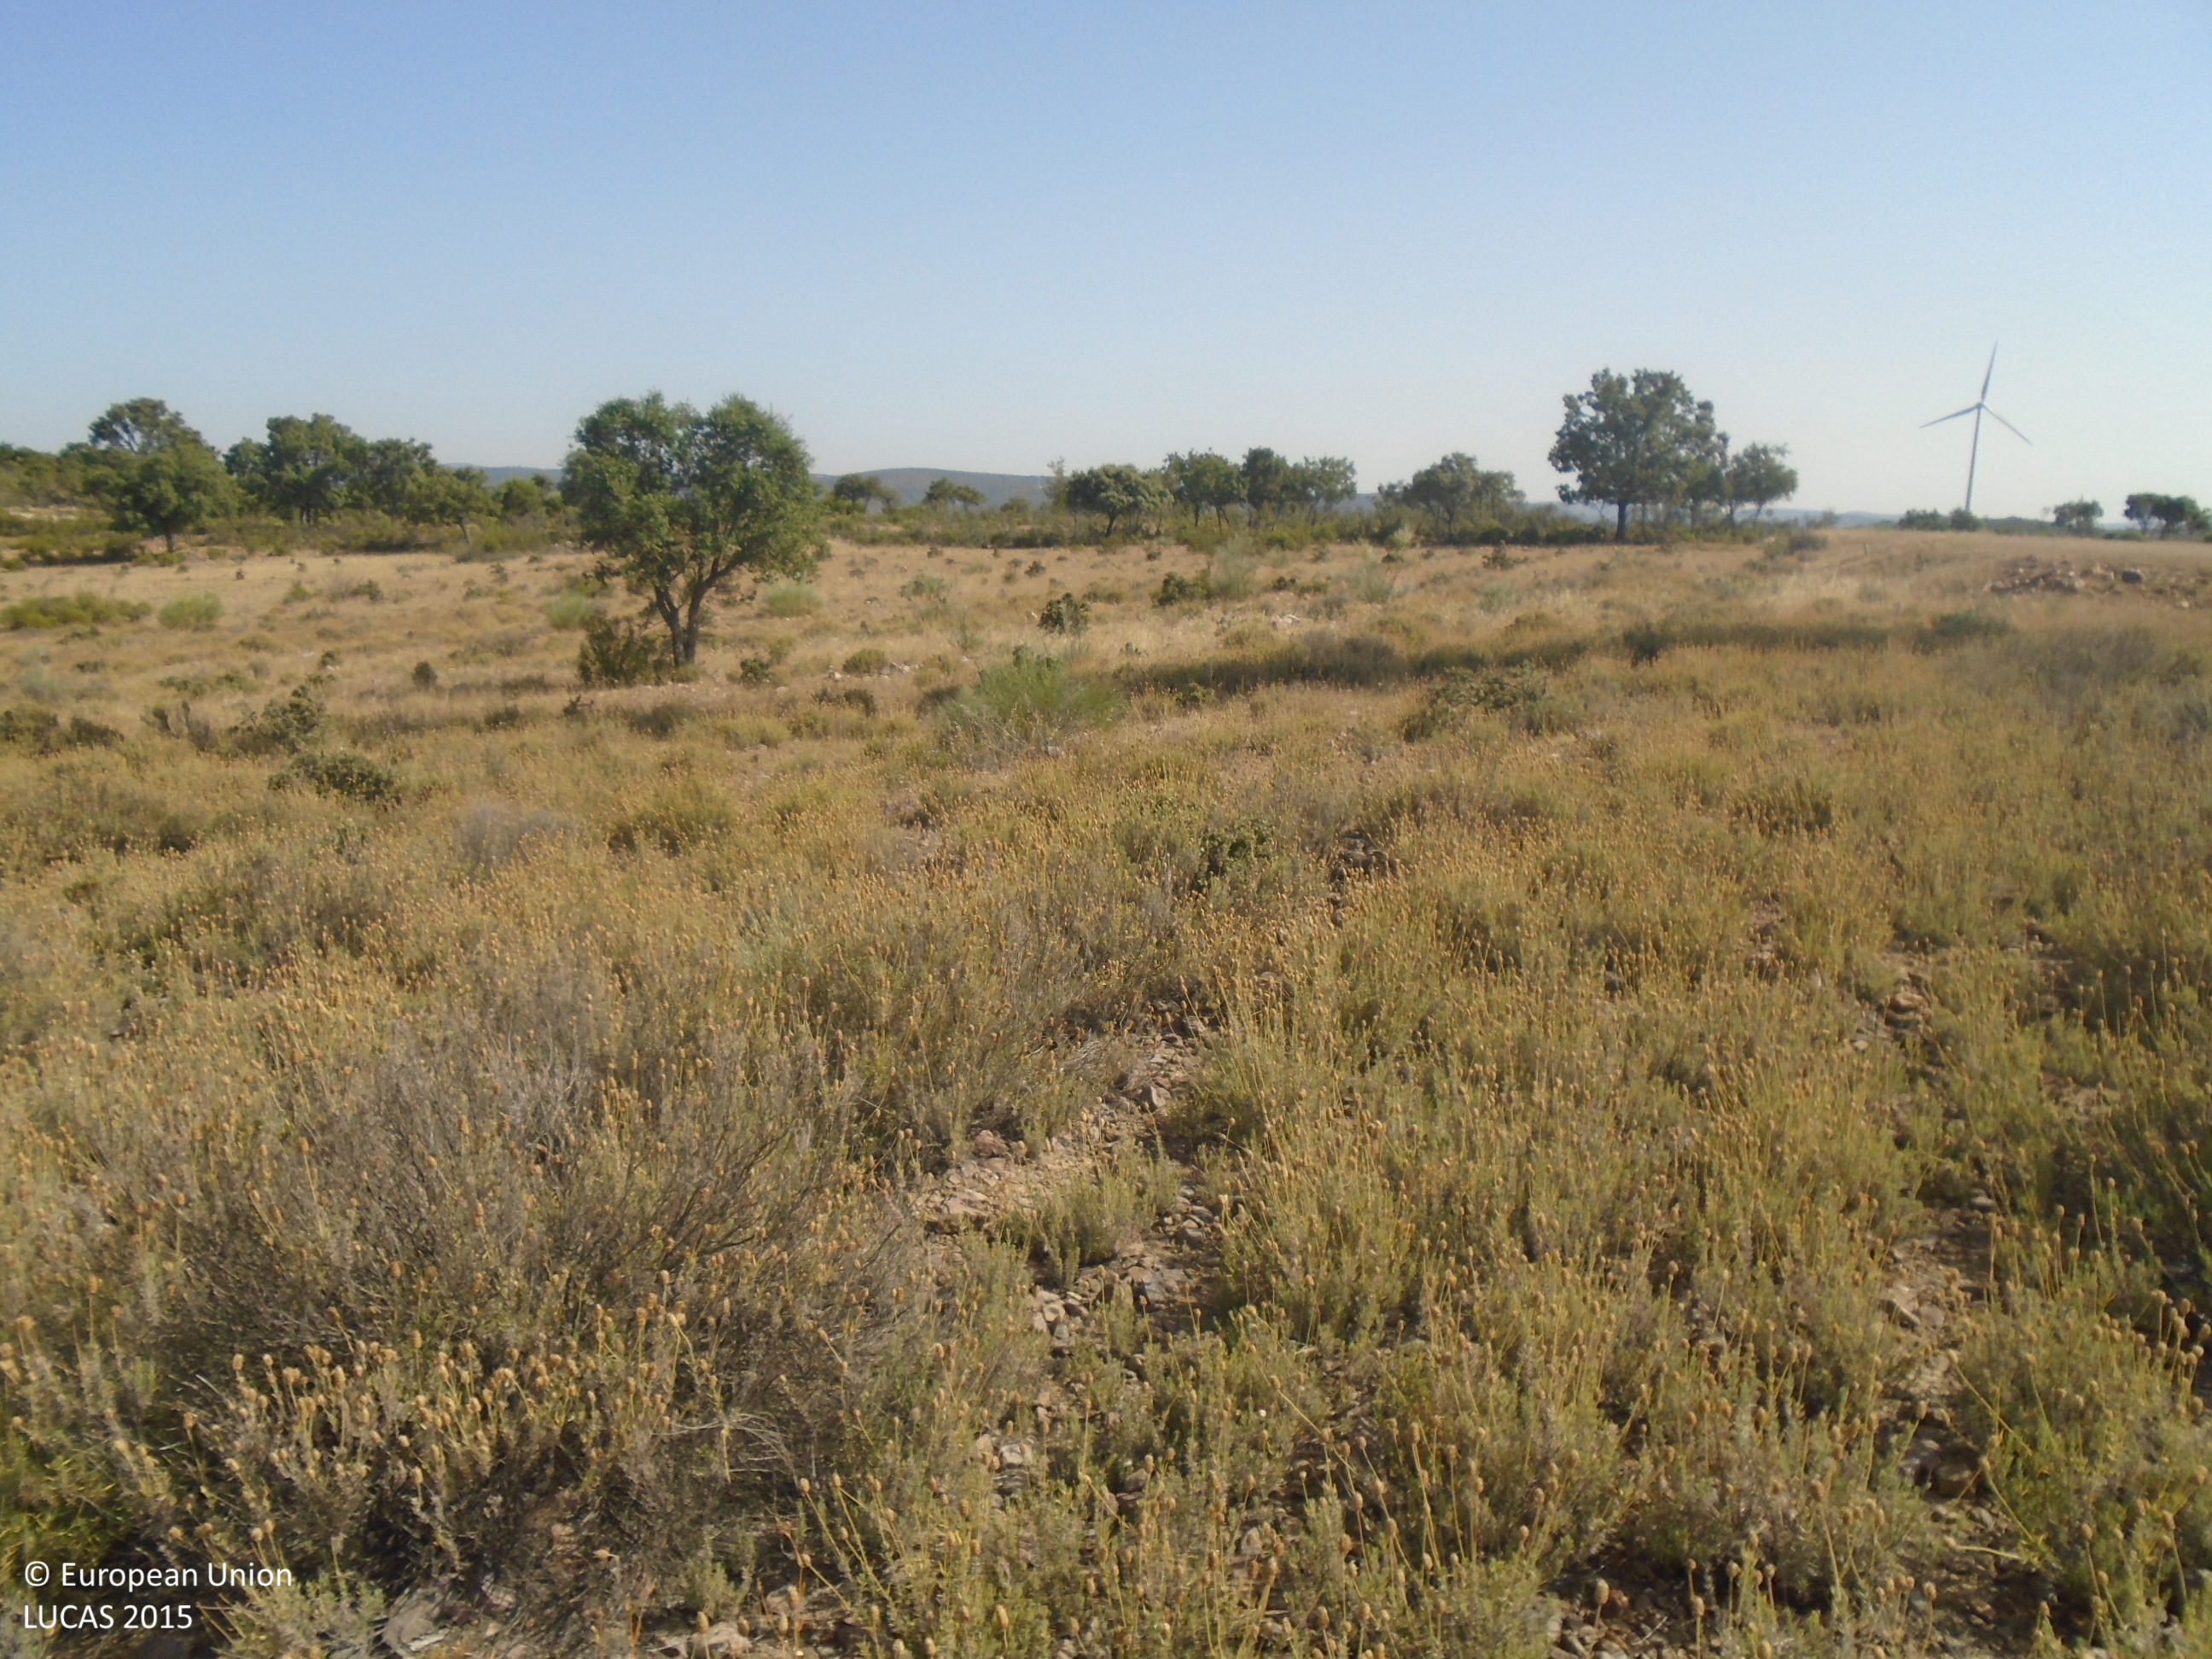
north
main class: Shrubland
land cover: Shrubland without tree cover
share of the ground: > 75 %
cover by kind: shrubs 100 %
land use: Agriculture (excluding fallow land and kitchen gardens)
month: July
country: ES
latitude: 39.2850
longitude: -4.0662
